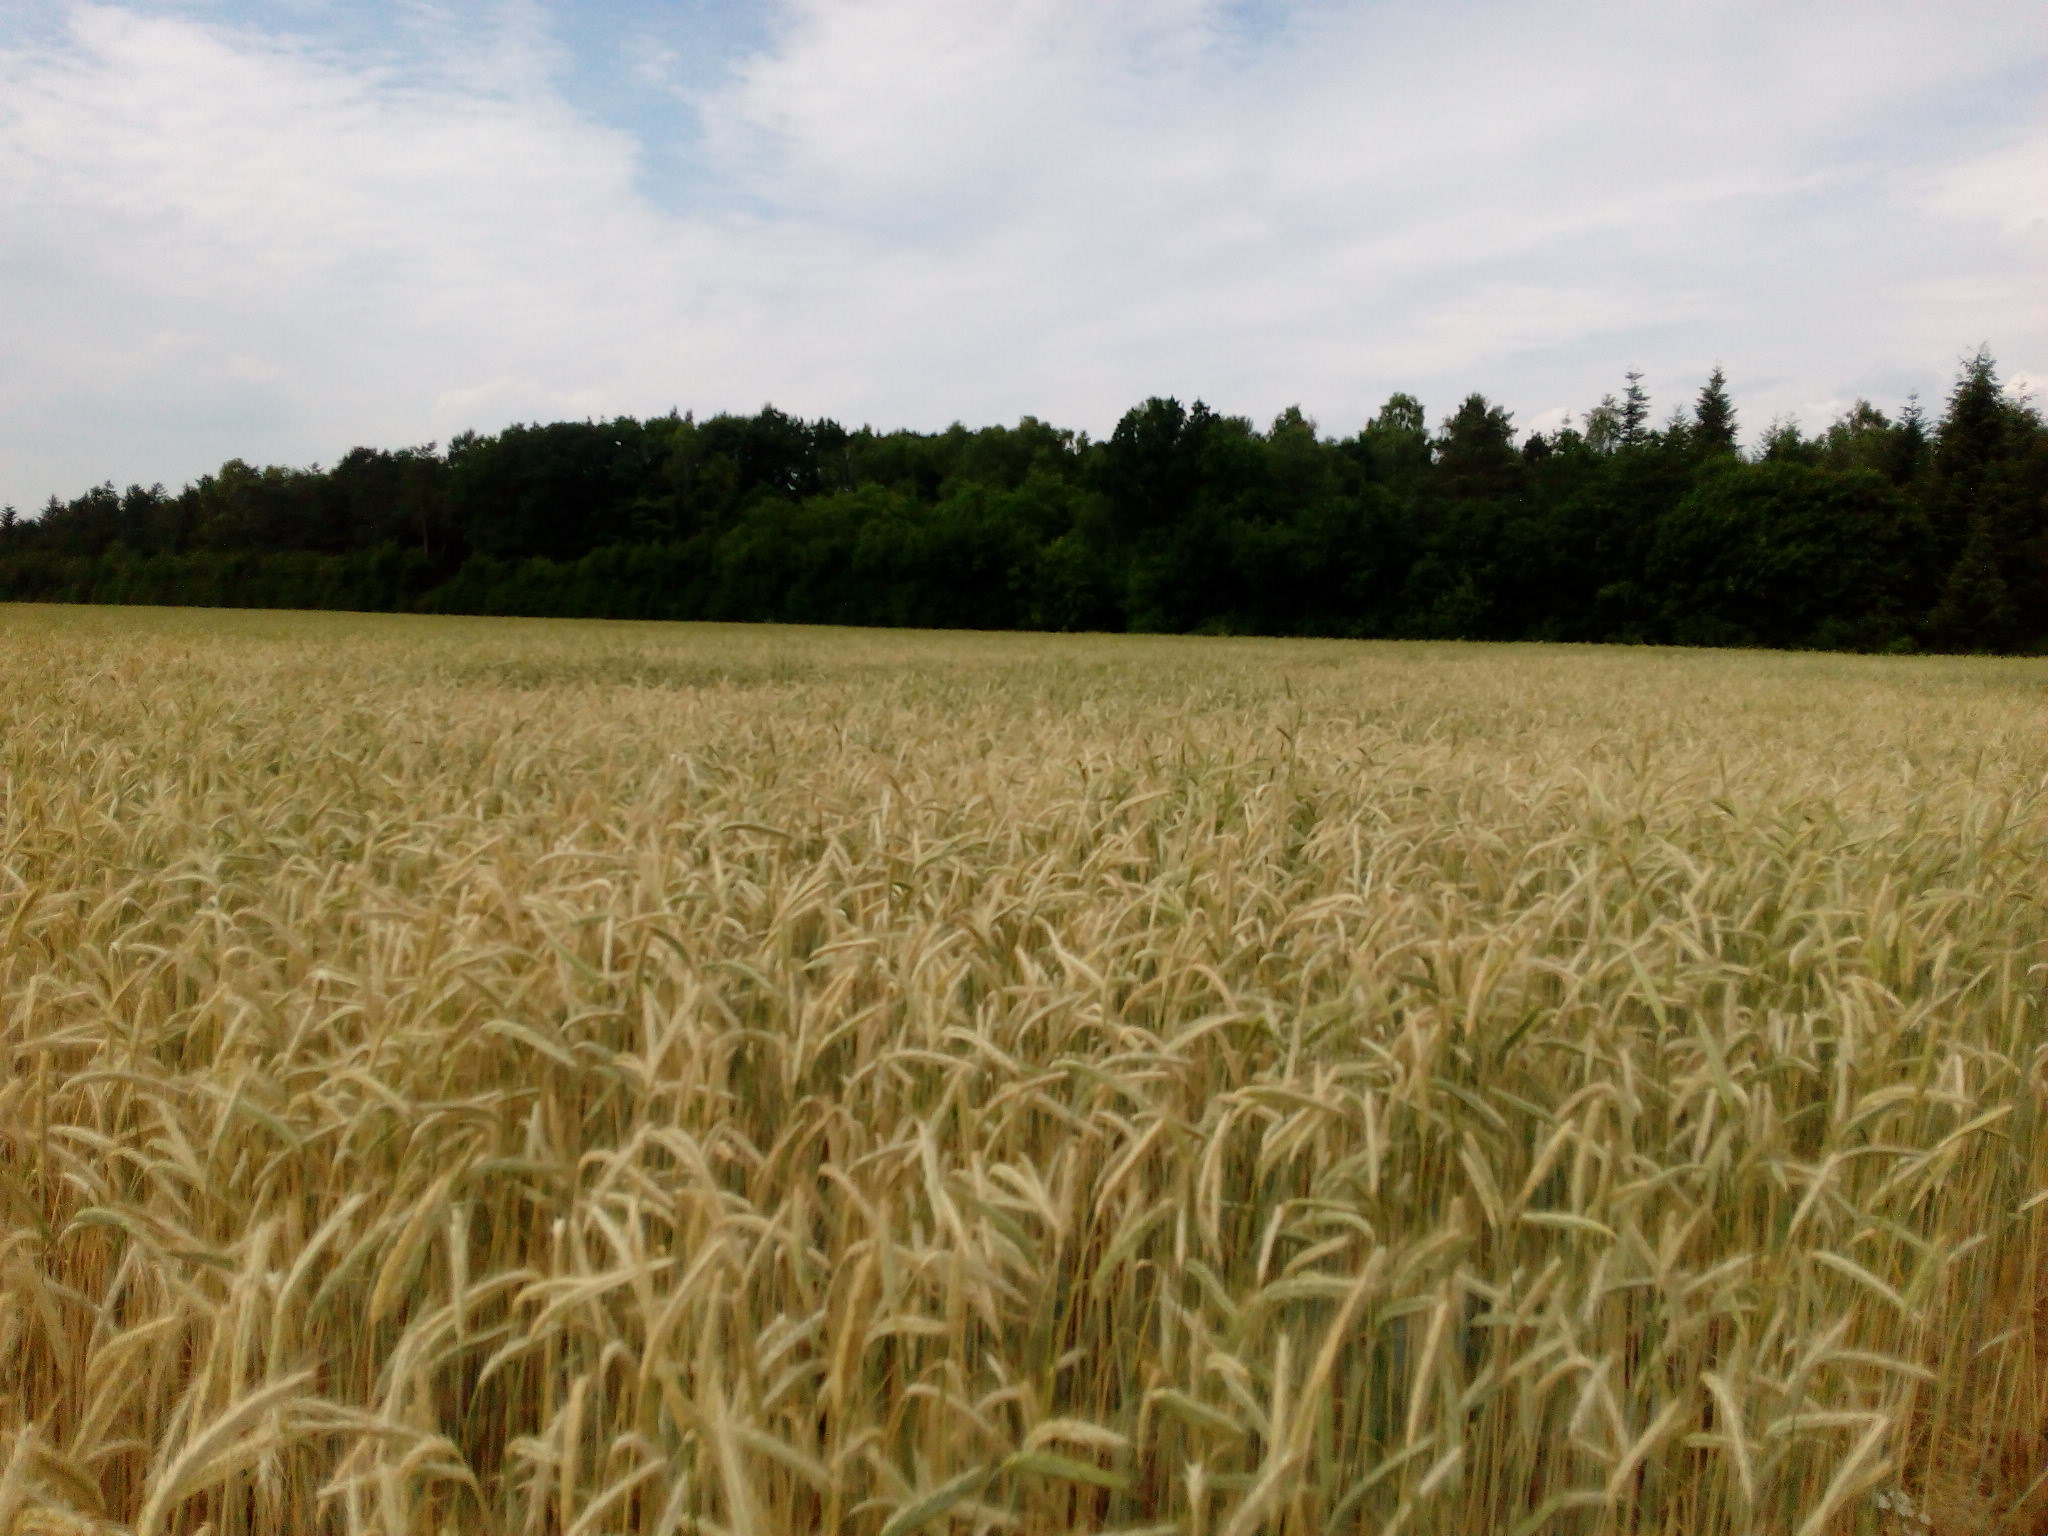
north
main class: Cropland
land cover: Rye
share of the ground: > 75 %
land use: Agriculture (excluding fallow land and kitchen gardens)
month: June
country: DE
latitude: 52.6470
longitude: 9.8670
